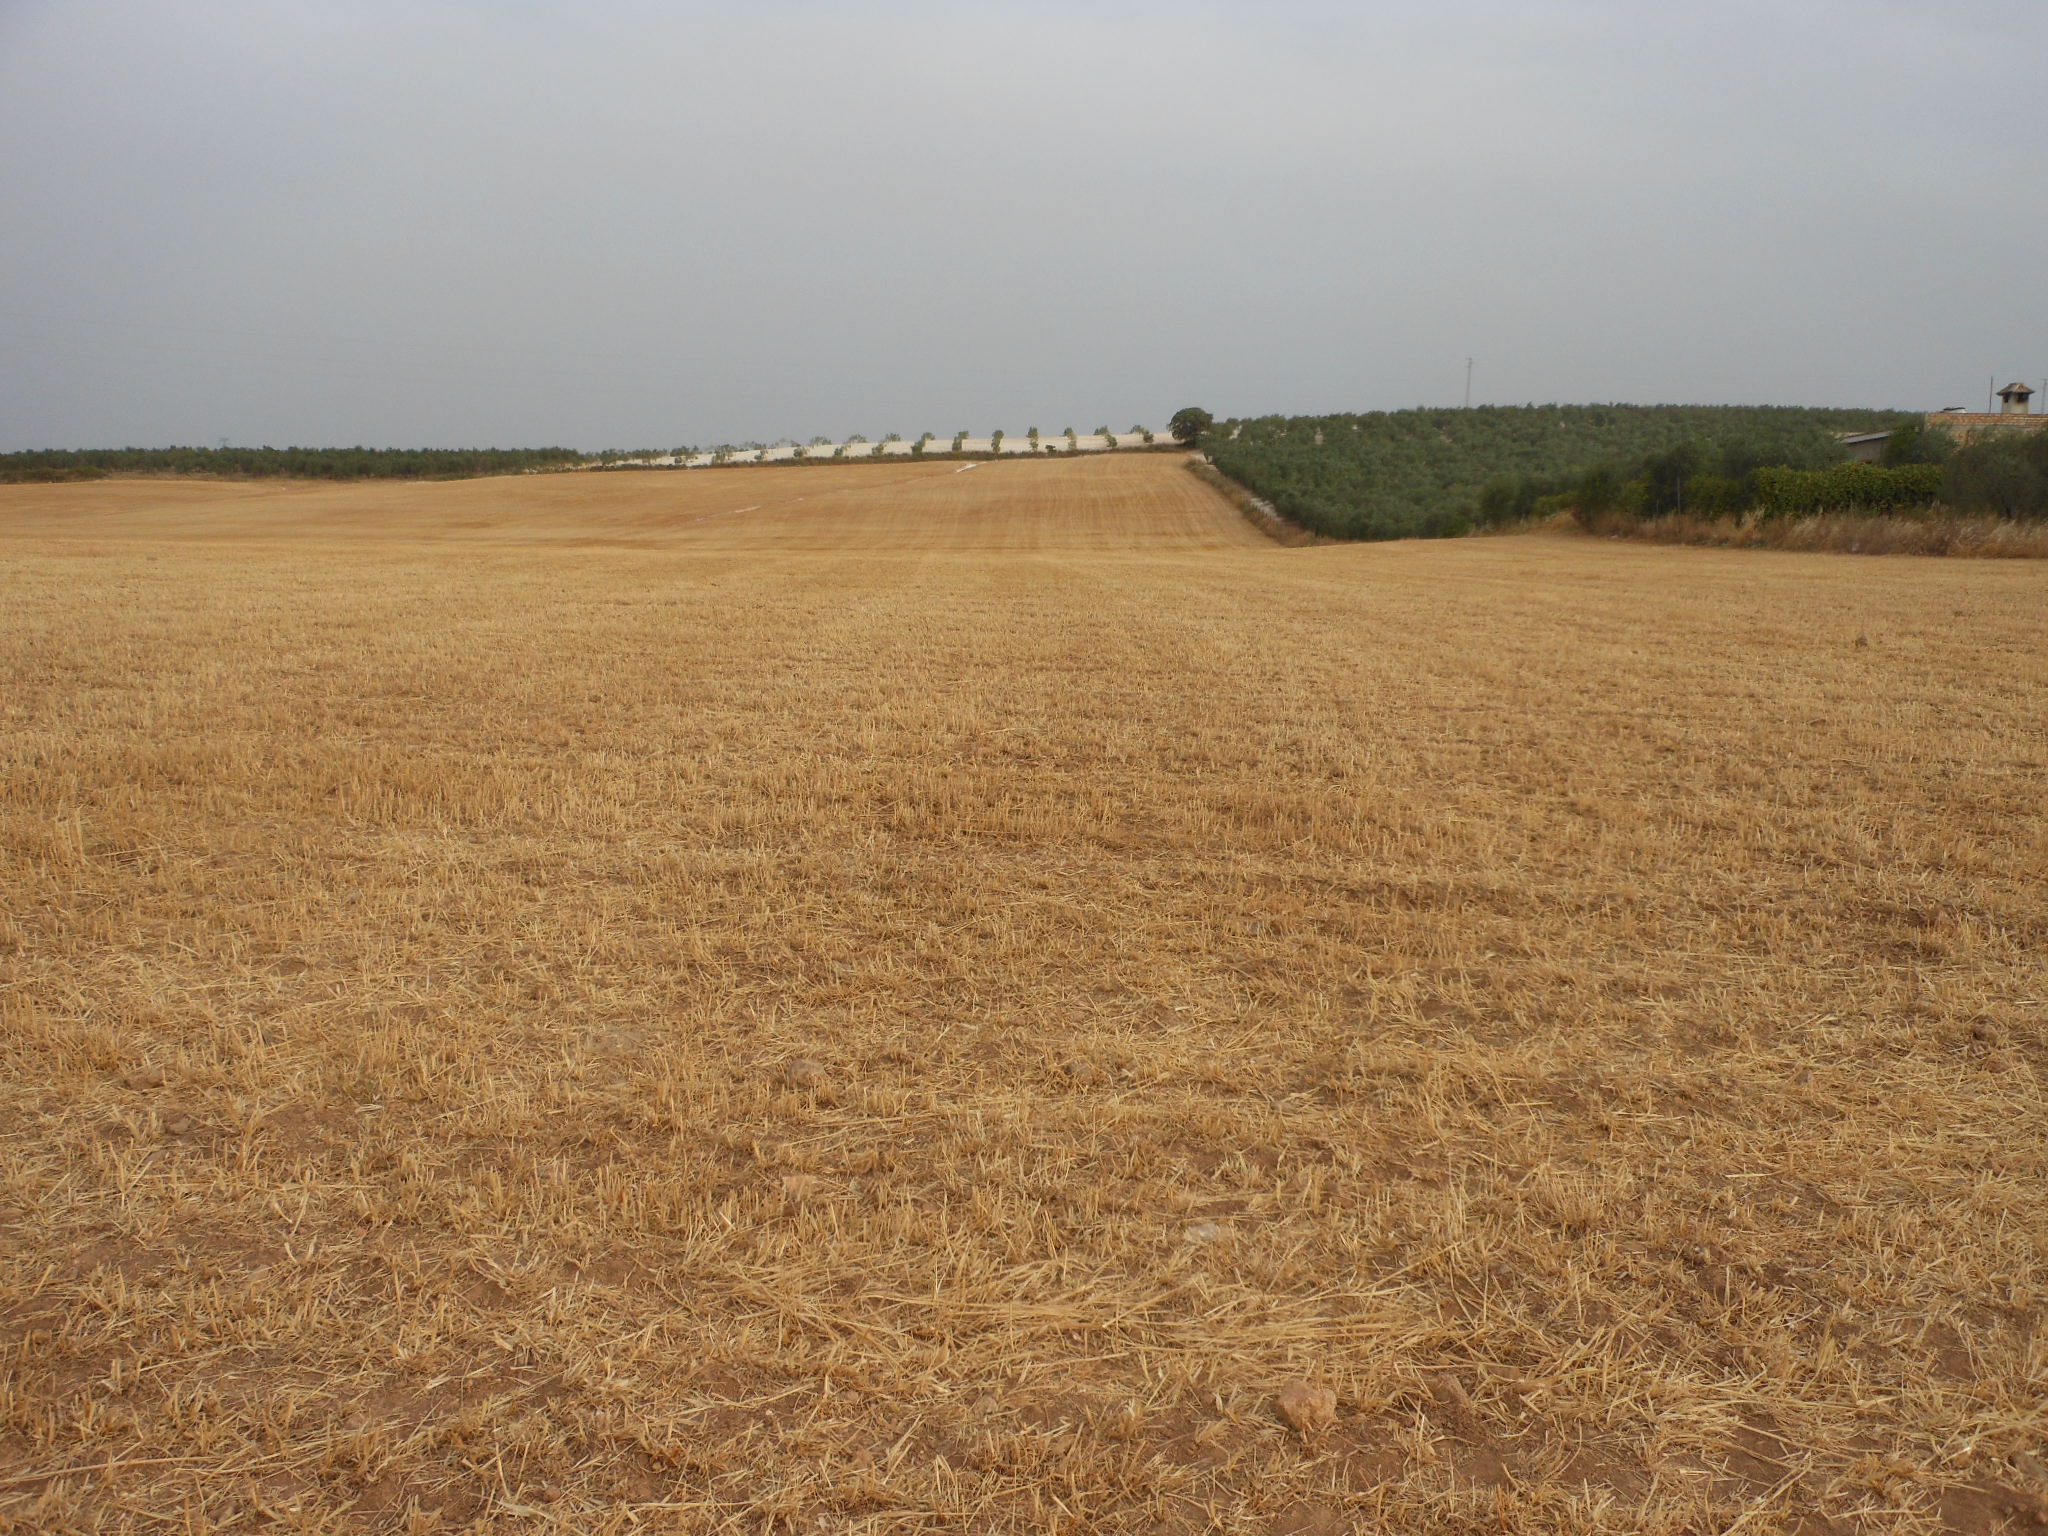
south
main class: Cropland
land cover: Oats
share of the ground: < 10 %
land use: Agriculture (excluding fallow land and kitchen gardens)
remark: Harvested field
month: June
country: ES
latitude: 37.1265
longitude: -5.4189
